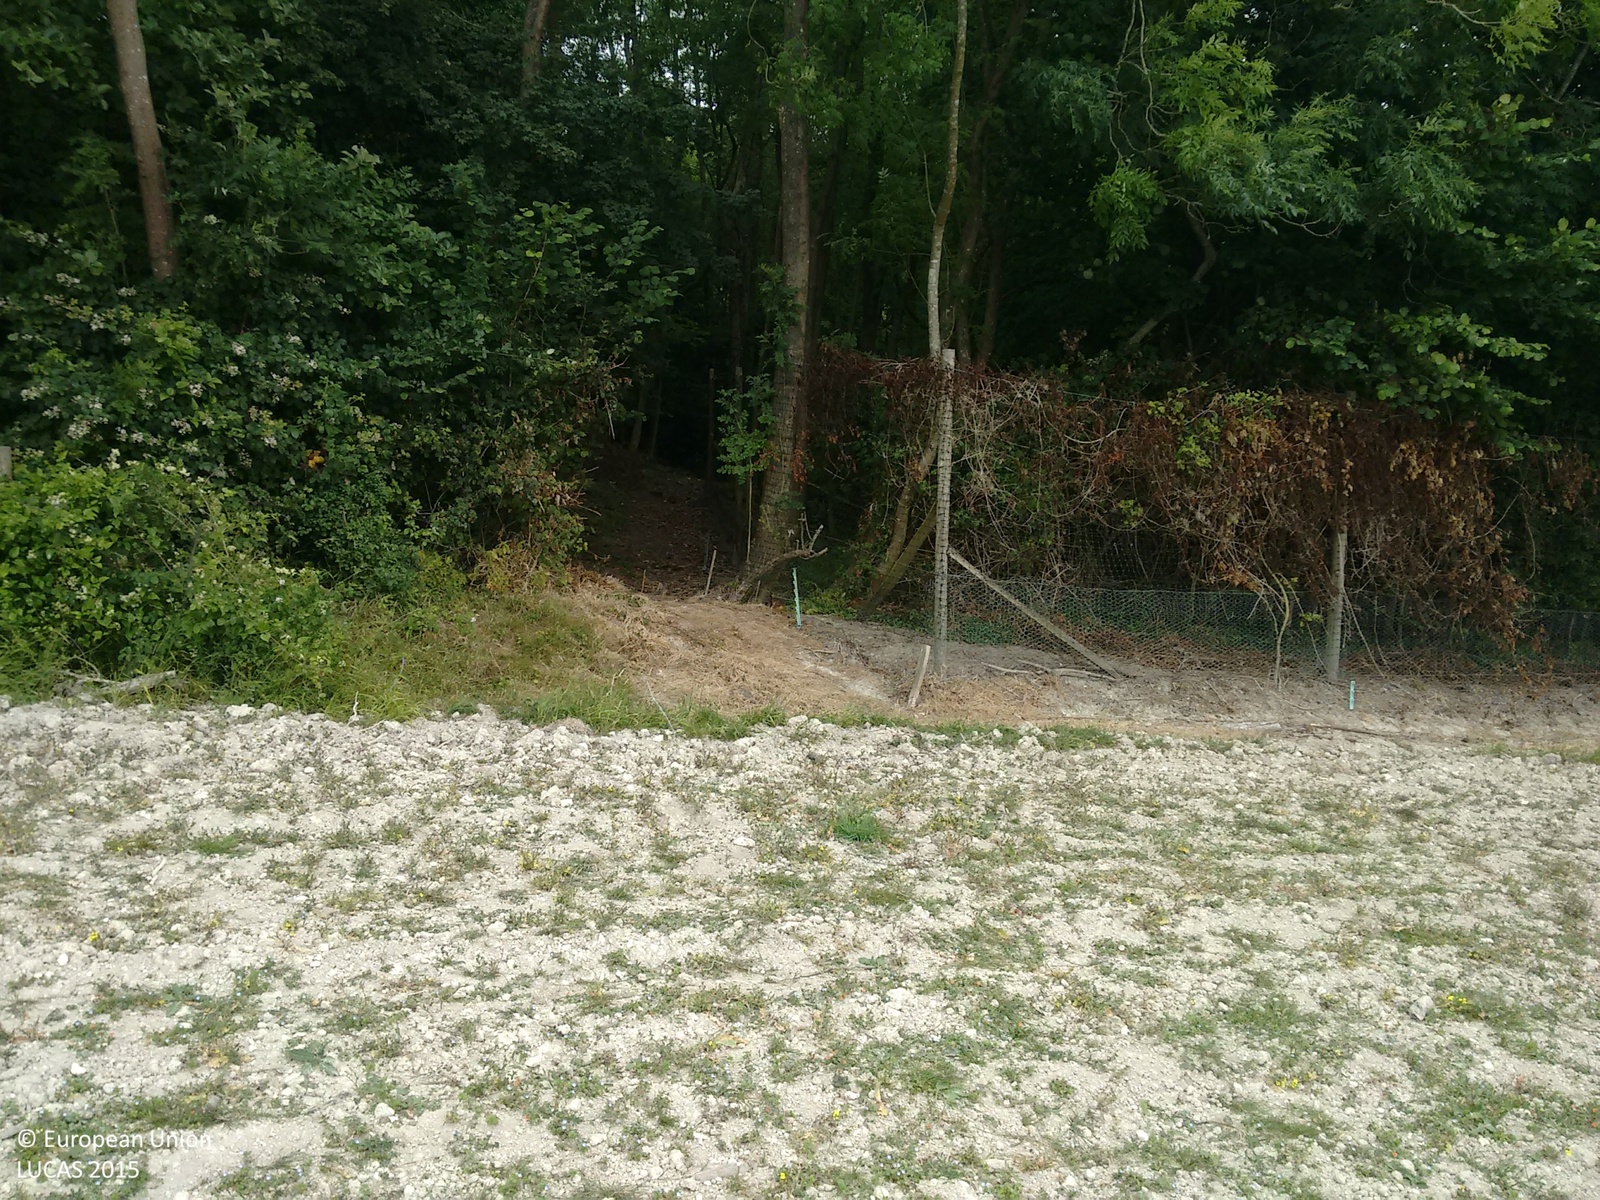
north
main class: Cropland
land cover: Common wheat
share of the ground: > 75 %
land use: Agriculture (excluding fallow land and kitchen gardens)
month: July
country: GB
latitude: 51.2312
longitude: -0.3913
